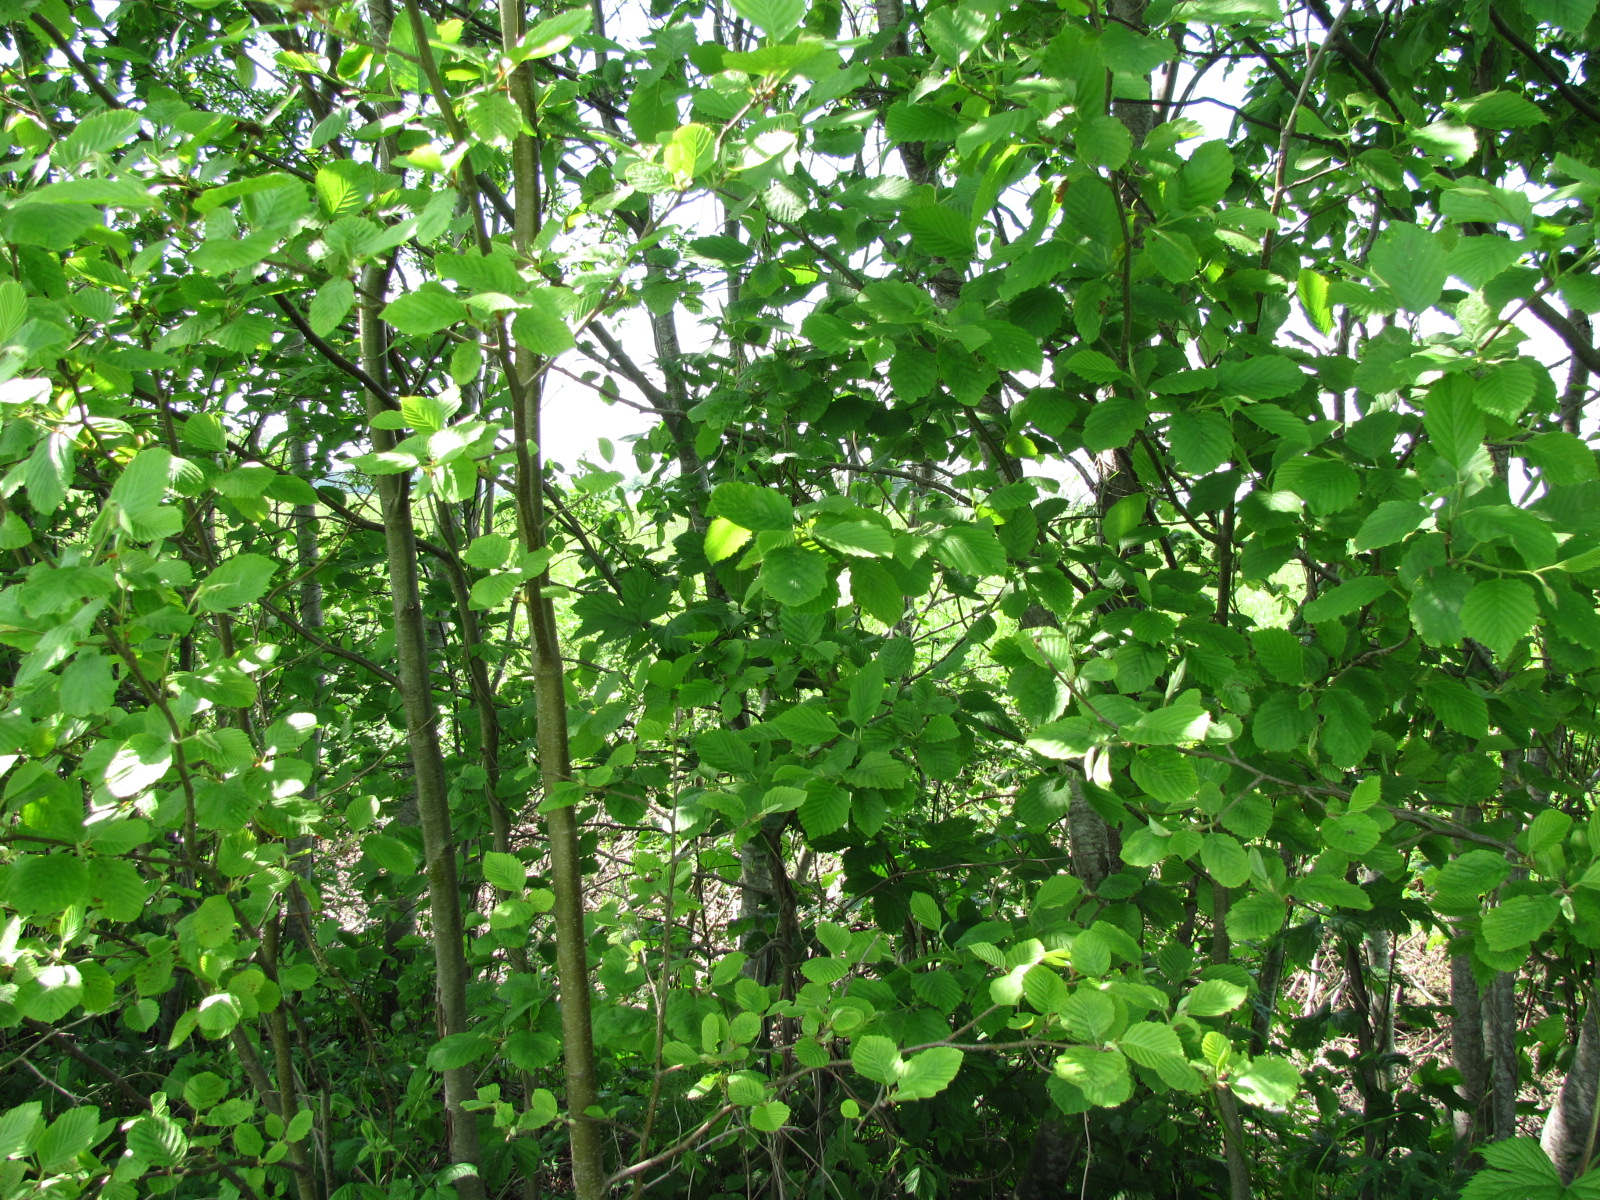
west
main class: Woodland
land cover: Broadleaved woodland
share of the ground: > 75 %
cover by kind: broadleaved forest trees 100 %
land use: Agriculture (excluding fallow land and kitchen gardens)
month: May
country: LV
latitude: 56.5459
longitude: 24.0246
